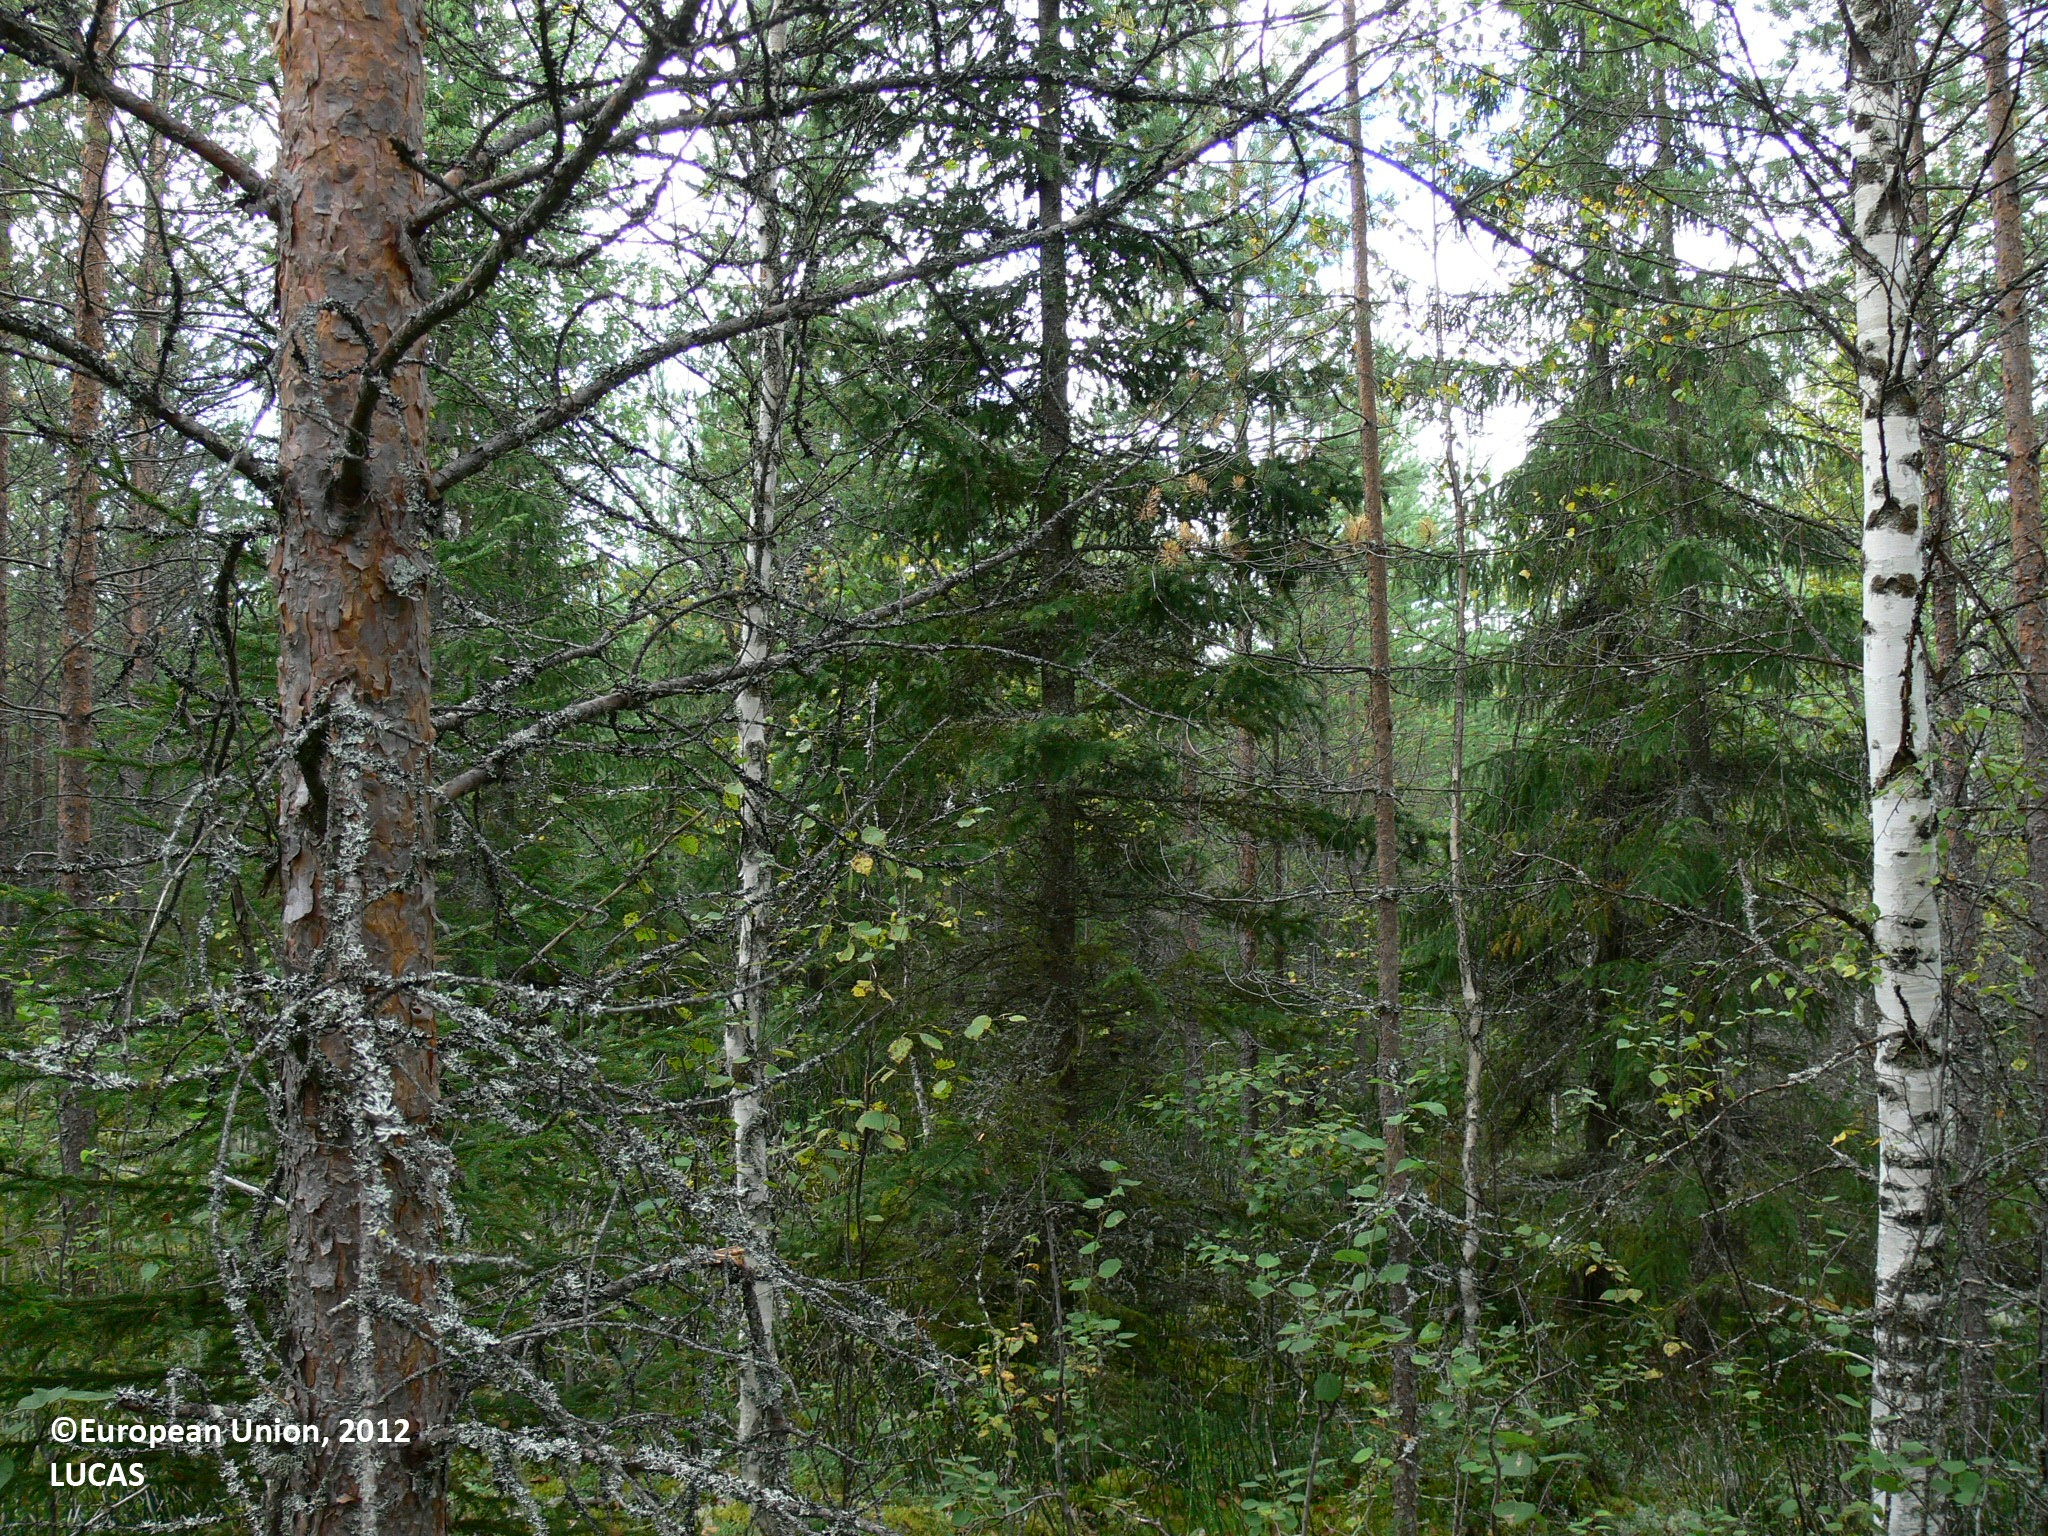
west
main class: Woodland
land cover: Other mixed woodland
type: boreal forest
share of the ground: > 75 %
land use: Forestry
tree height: > 5 m
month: August
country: FI
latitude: 63.2861
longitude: 30.3025
